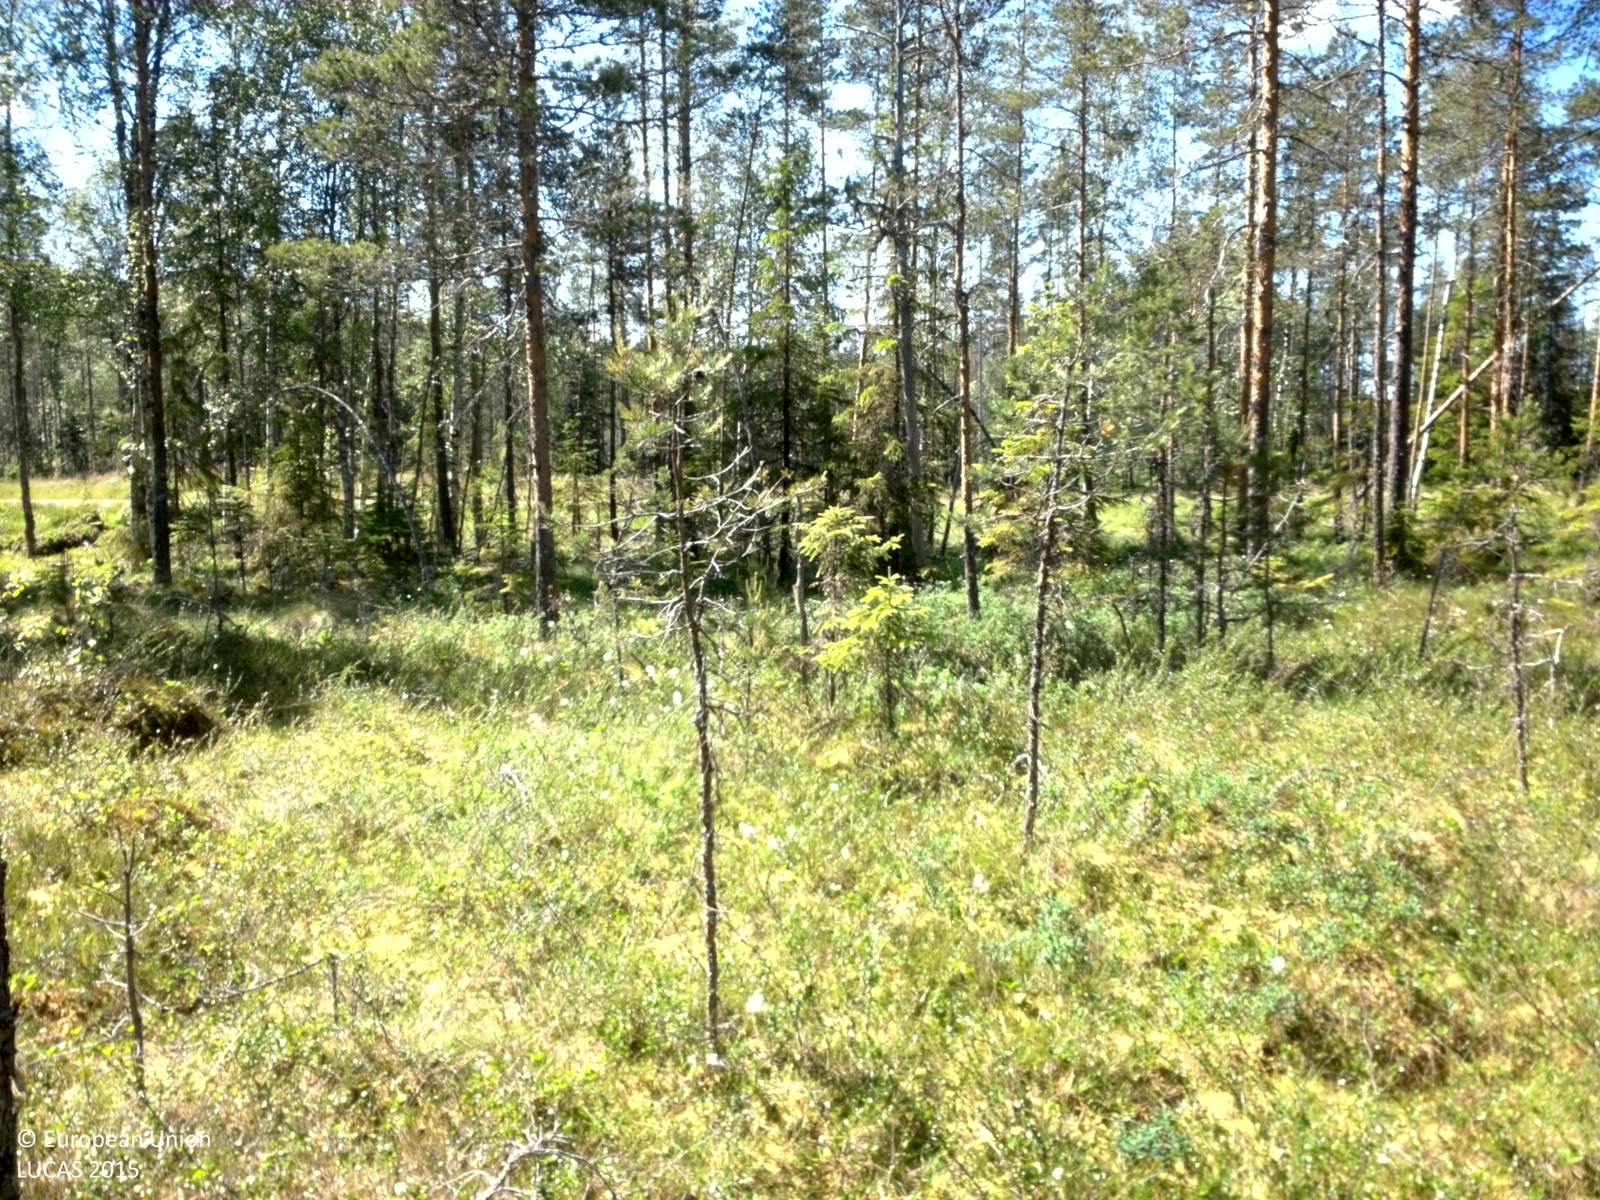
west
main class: Woodland
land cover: Pine dominated coniferous woodland
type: mire and swamp forests
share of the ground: 10 - 25 %
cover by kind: shrubs 50 %, lichens and mosses 30 %, coniferous forest trees 20 %
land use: Semi-natural and natural areas not in use
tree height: > 5 m
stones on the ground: < 10 %
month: July
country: SE
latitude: 60.4177
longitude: 13.0598
